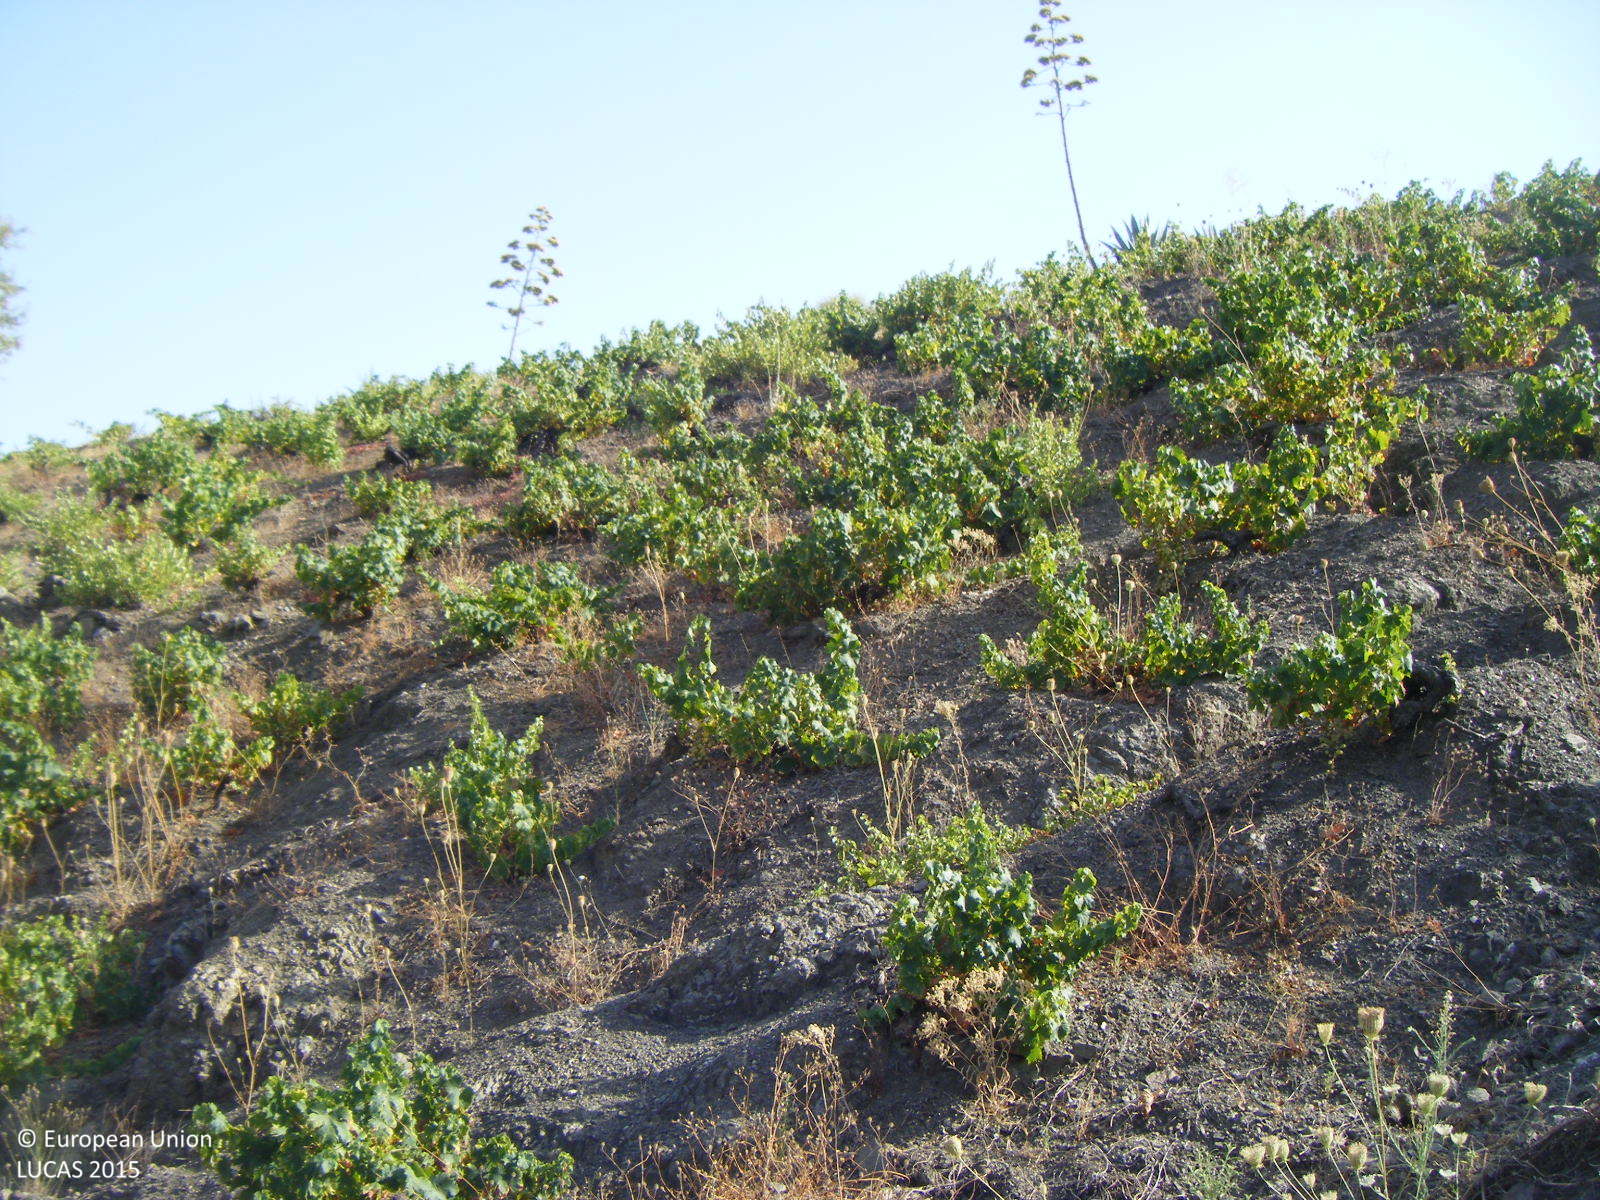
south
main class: Cropland
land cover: Vineyards
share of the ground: 10 - 25 %
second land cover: Other bare soil
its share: > 75 %
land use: Agriculture (excluding fallow land and kitchen gardens)
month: July
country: ES
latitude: 36.8174
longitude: -4.2378
